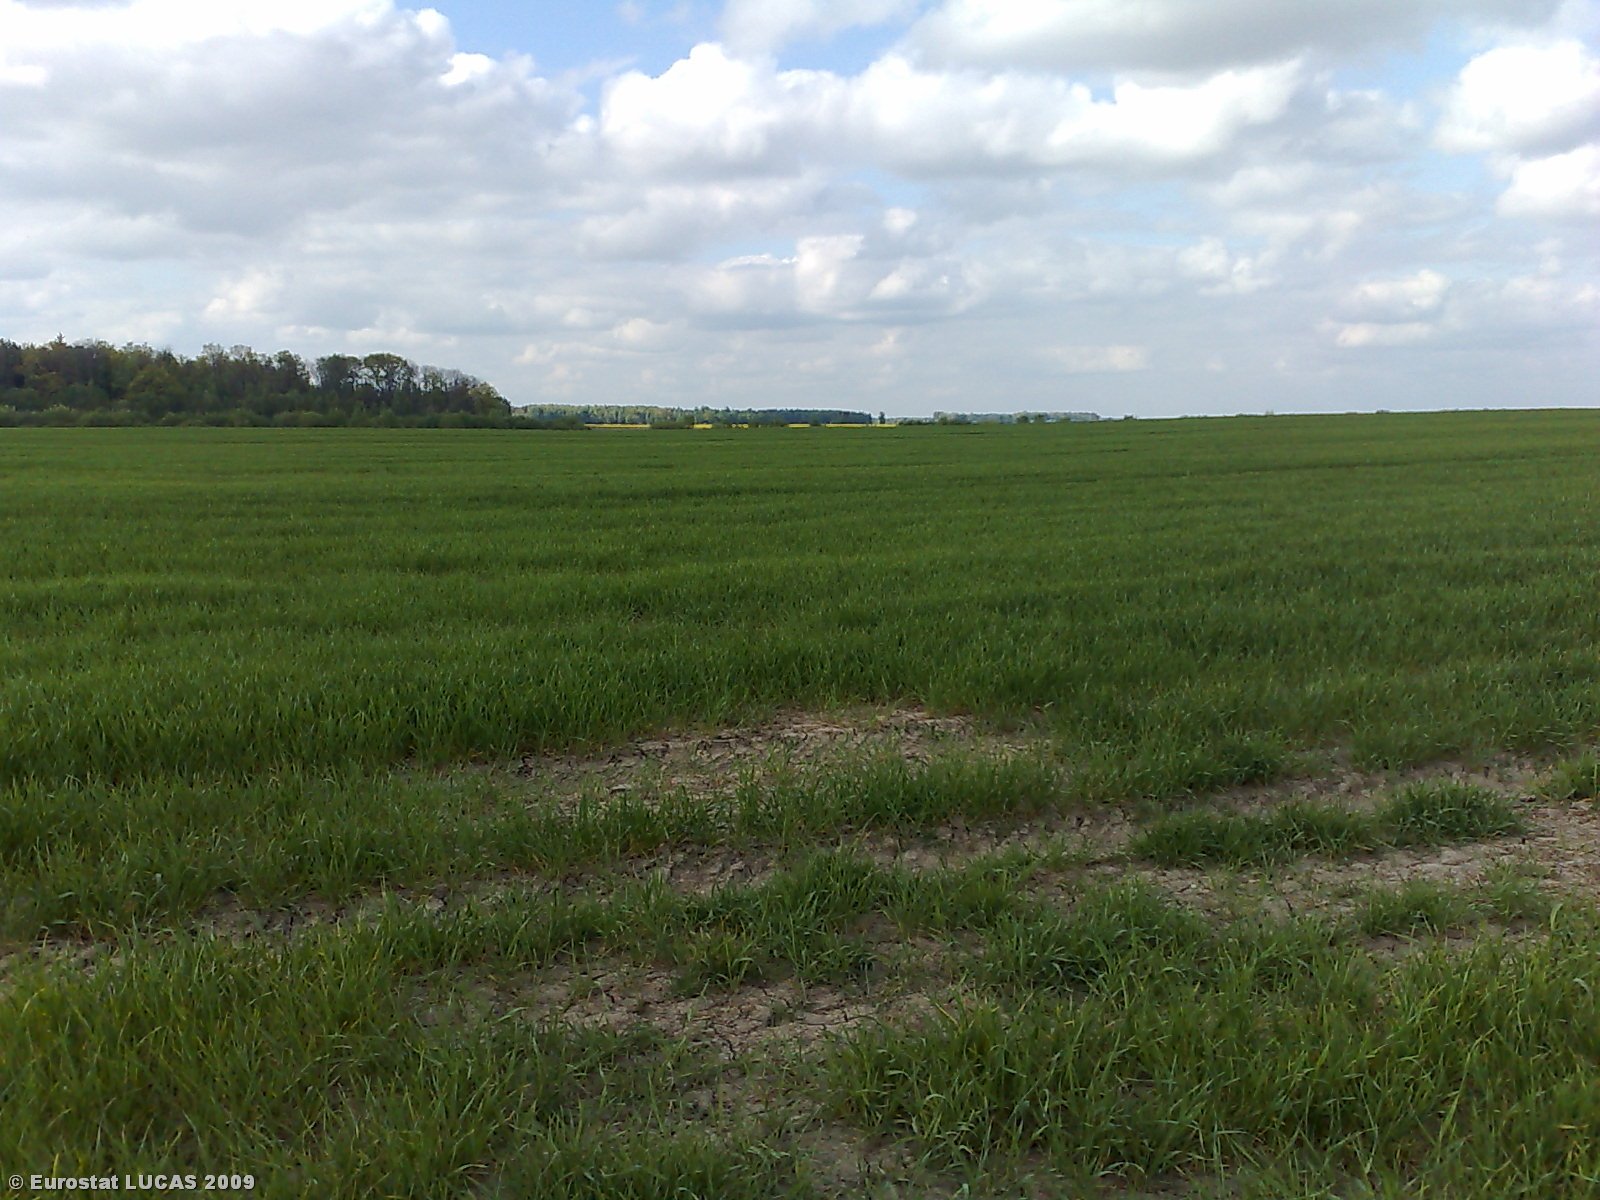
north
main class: Cropland
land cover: Common wheat
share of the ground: 50 - 75 %
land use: Agriculture (excluding fallow land and kitchen gardens)
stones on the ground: < 10 %
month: May
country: LT
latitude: 55.5616
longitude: 23.8321
